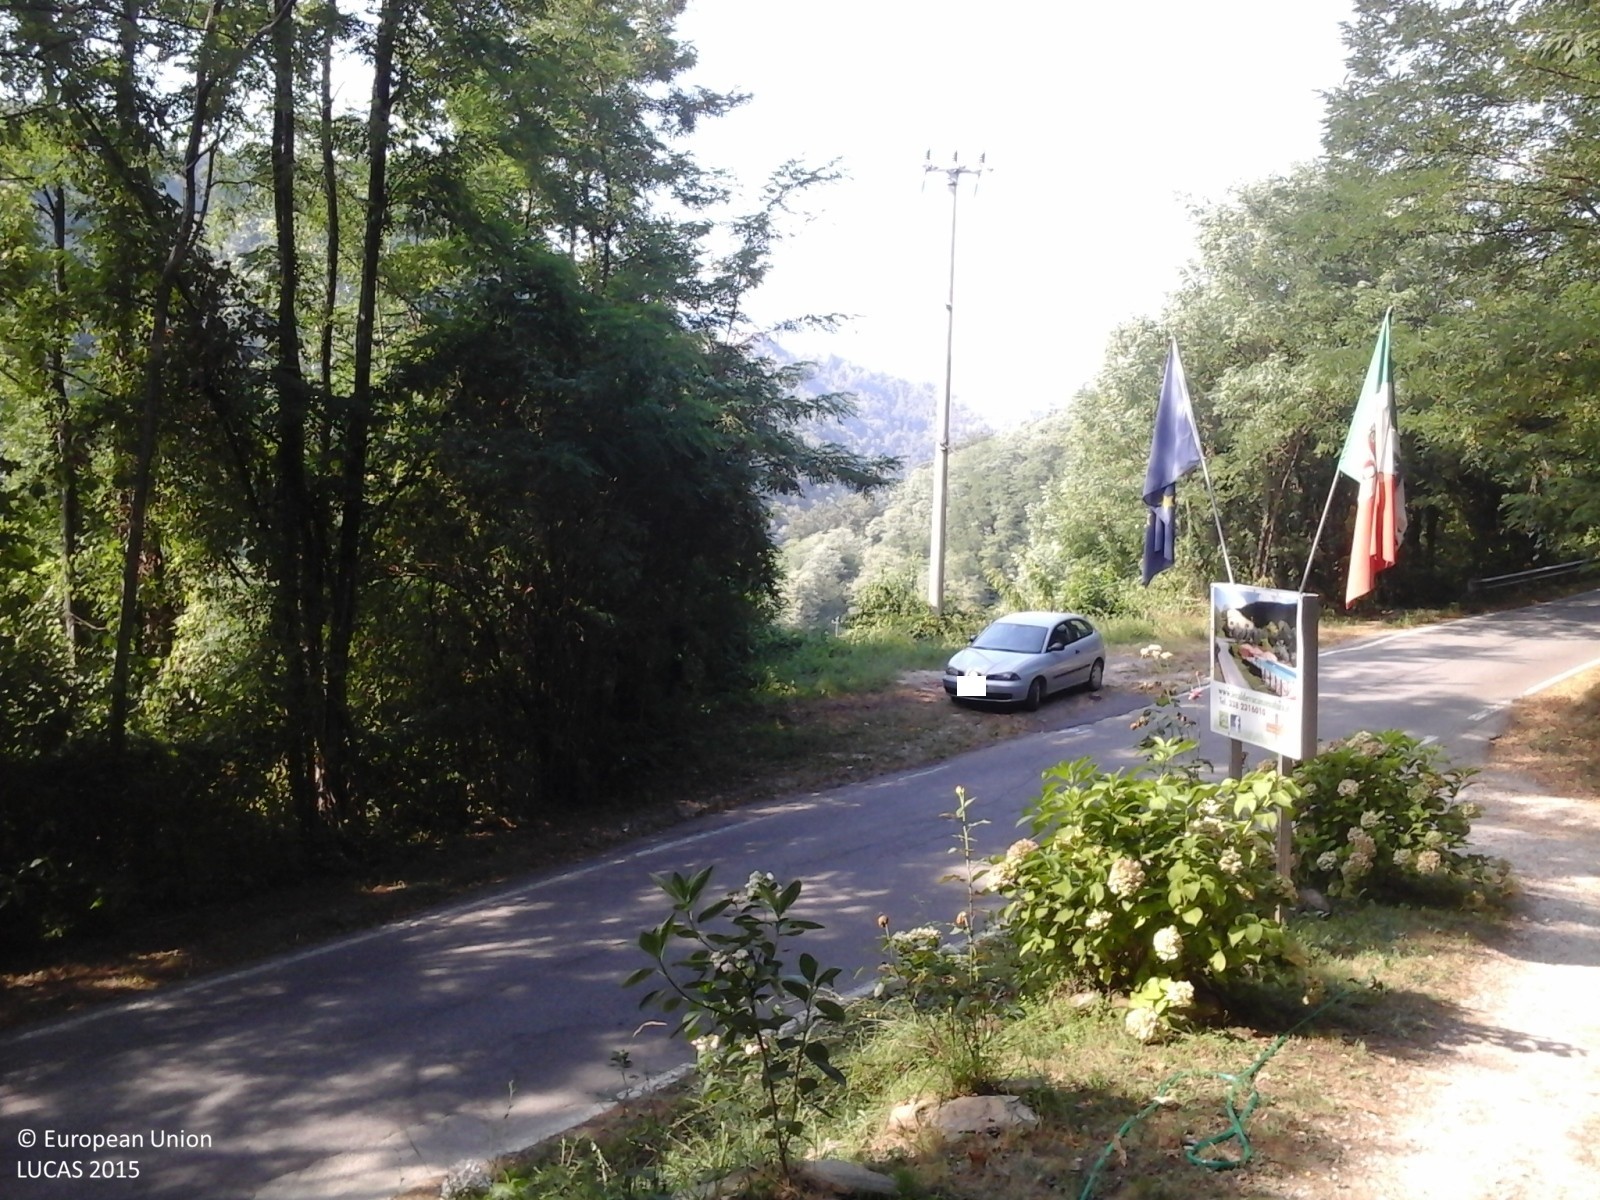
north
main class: Woodland
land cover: Broadleaved woodland
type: thermophilous deciduous forest
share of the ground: > 75 %
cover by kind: broadleaved forest trees 100 %
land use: Forestry
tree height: > 5 m
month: August
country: IT
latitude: 43.9332
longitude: 10.7082
